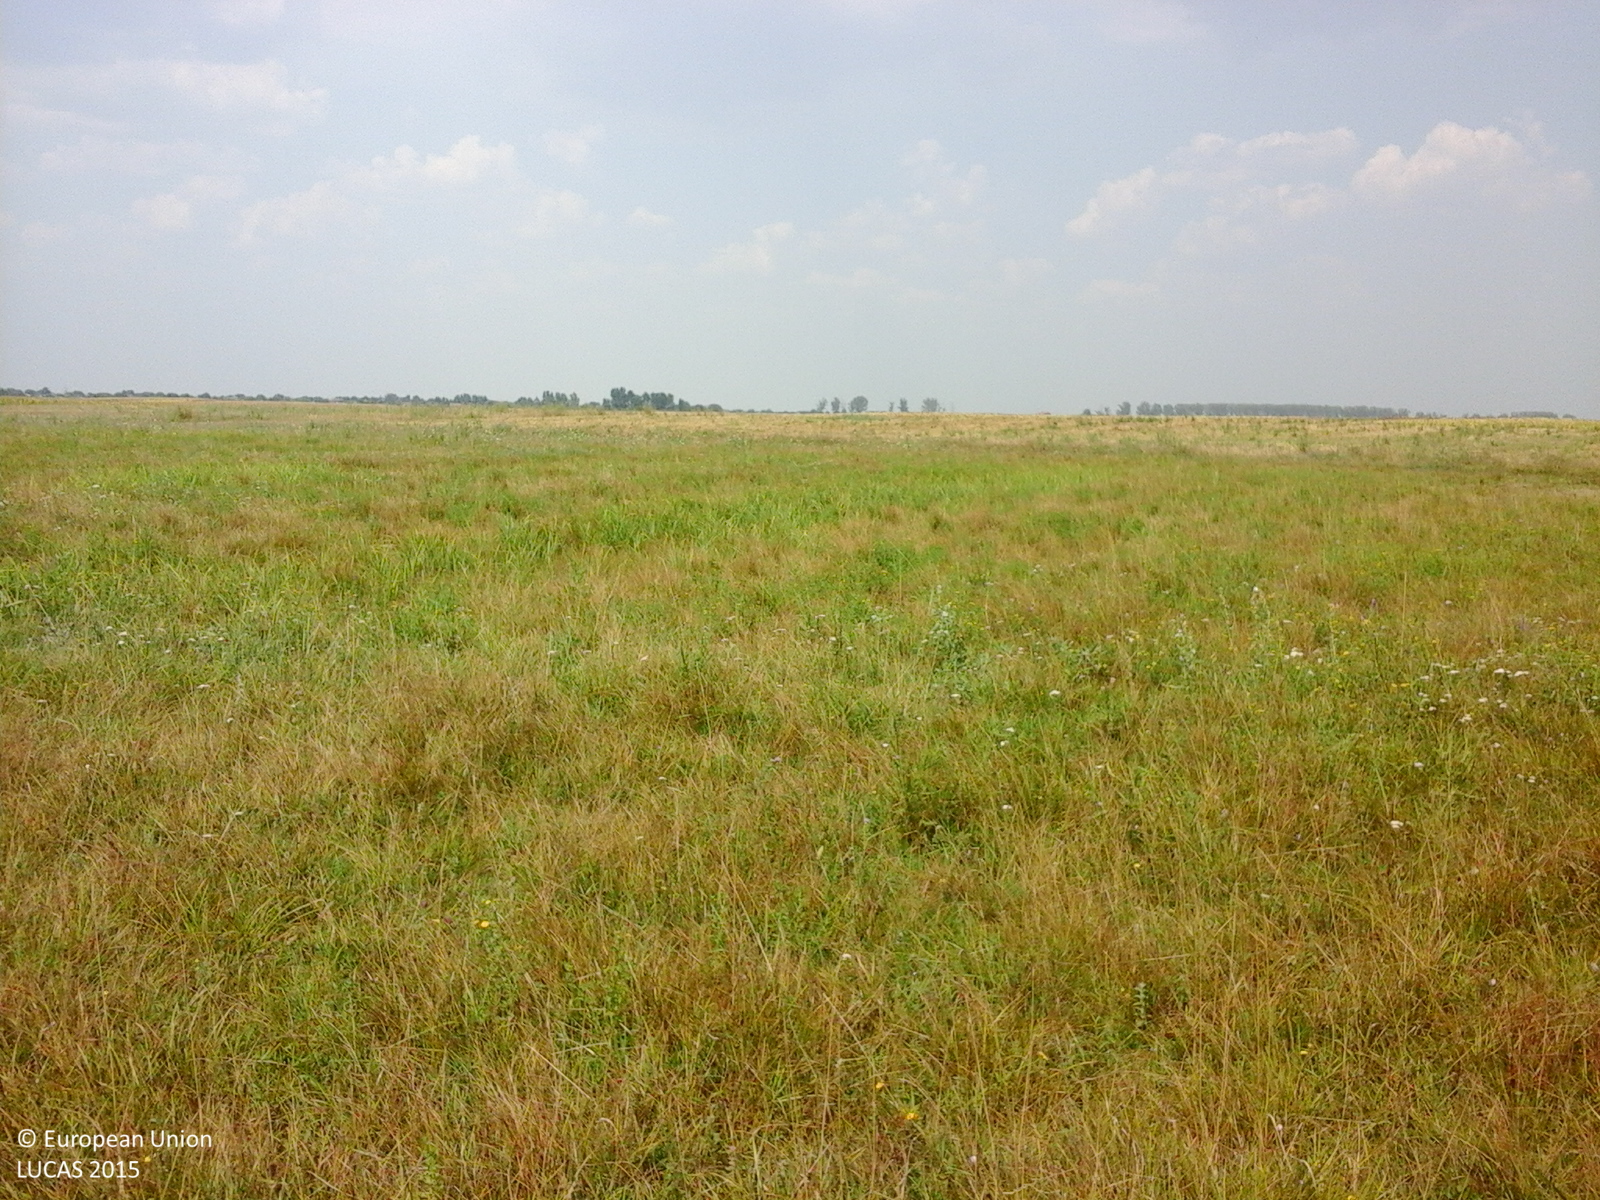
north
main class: Grassland
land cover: Grassland without tree/shrub cover
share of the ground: > 75 %
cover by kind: herbaceous plants 100 %
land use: Agriculture (excluding fallow land and kitchen gardens)
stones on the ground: < 10 %
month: August
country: RO
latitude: 43.9074
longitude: 23.1797
